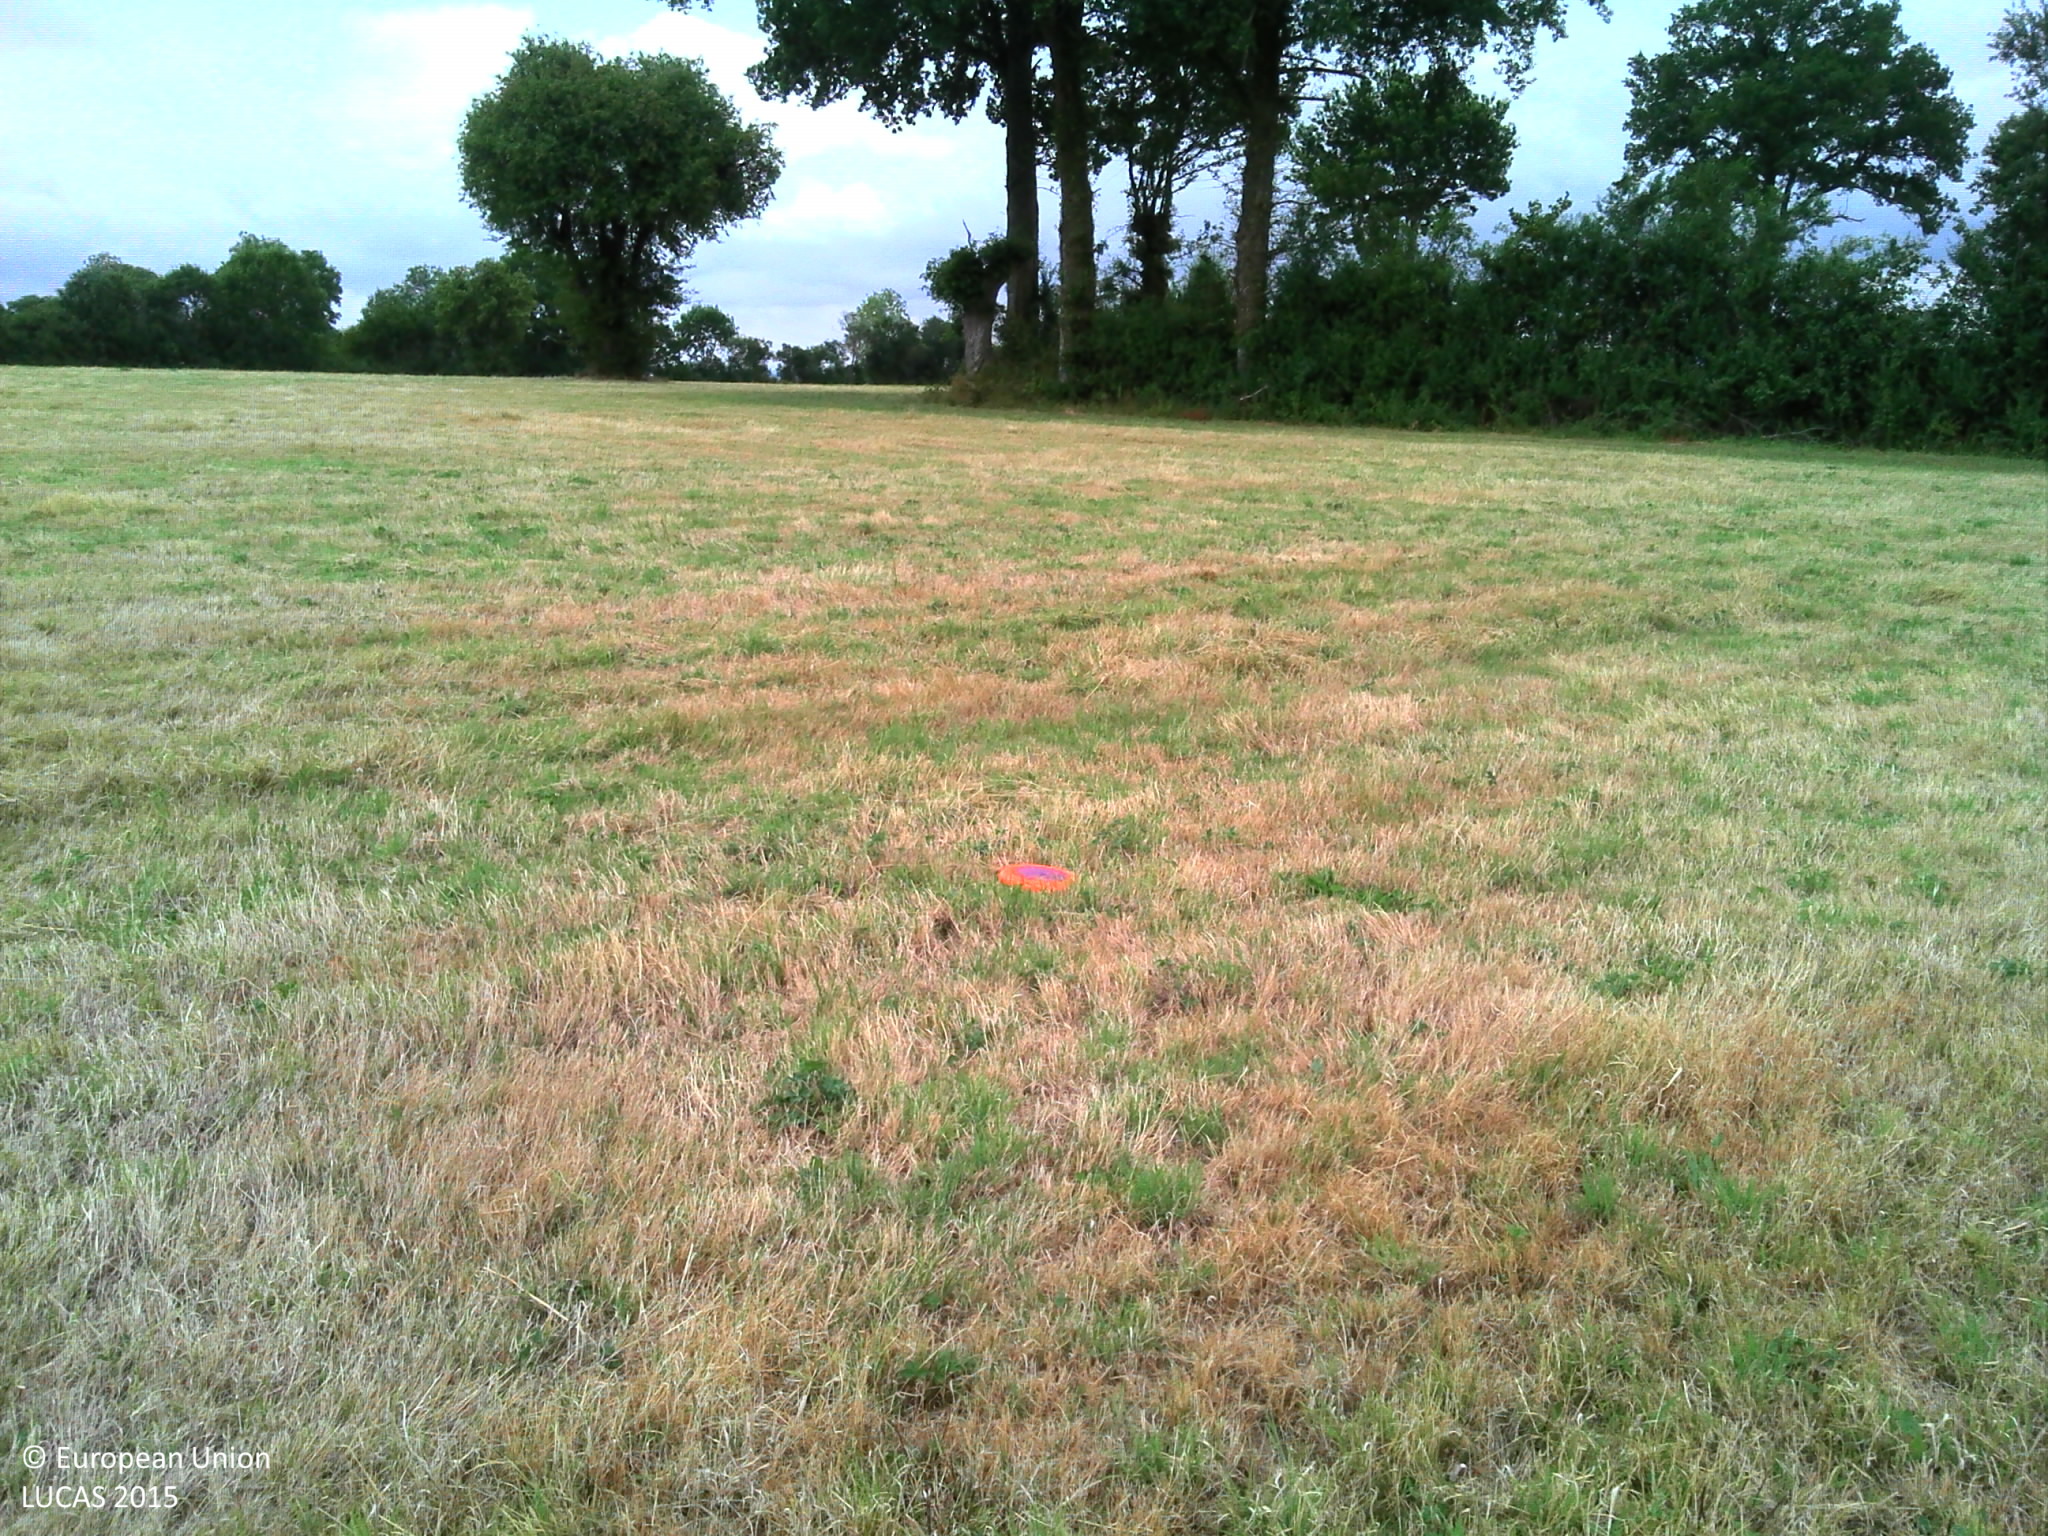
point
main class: Grassland
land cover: Grassland without tree/shrub cover
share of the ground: > 75 %
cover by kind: herbaceous plants 100 %
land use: Agriculture (excluding fallow land and kitchen gardens)
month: July
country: FR
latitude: 48.4270
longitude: -0.1258
